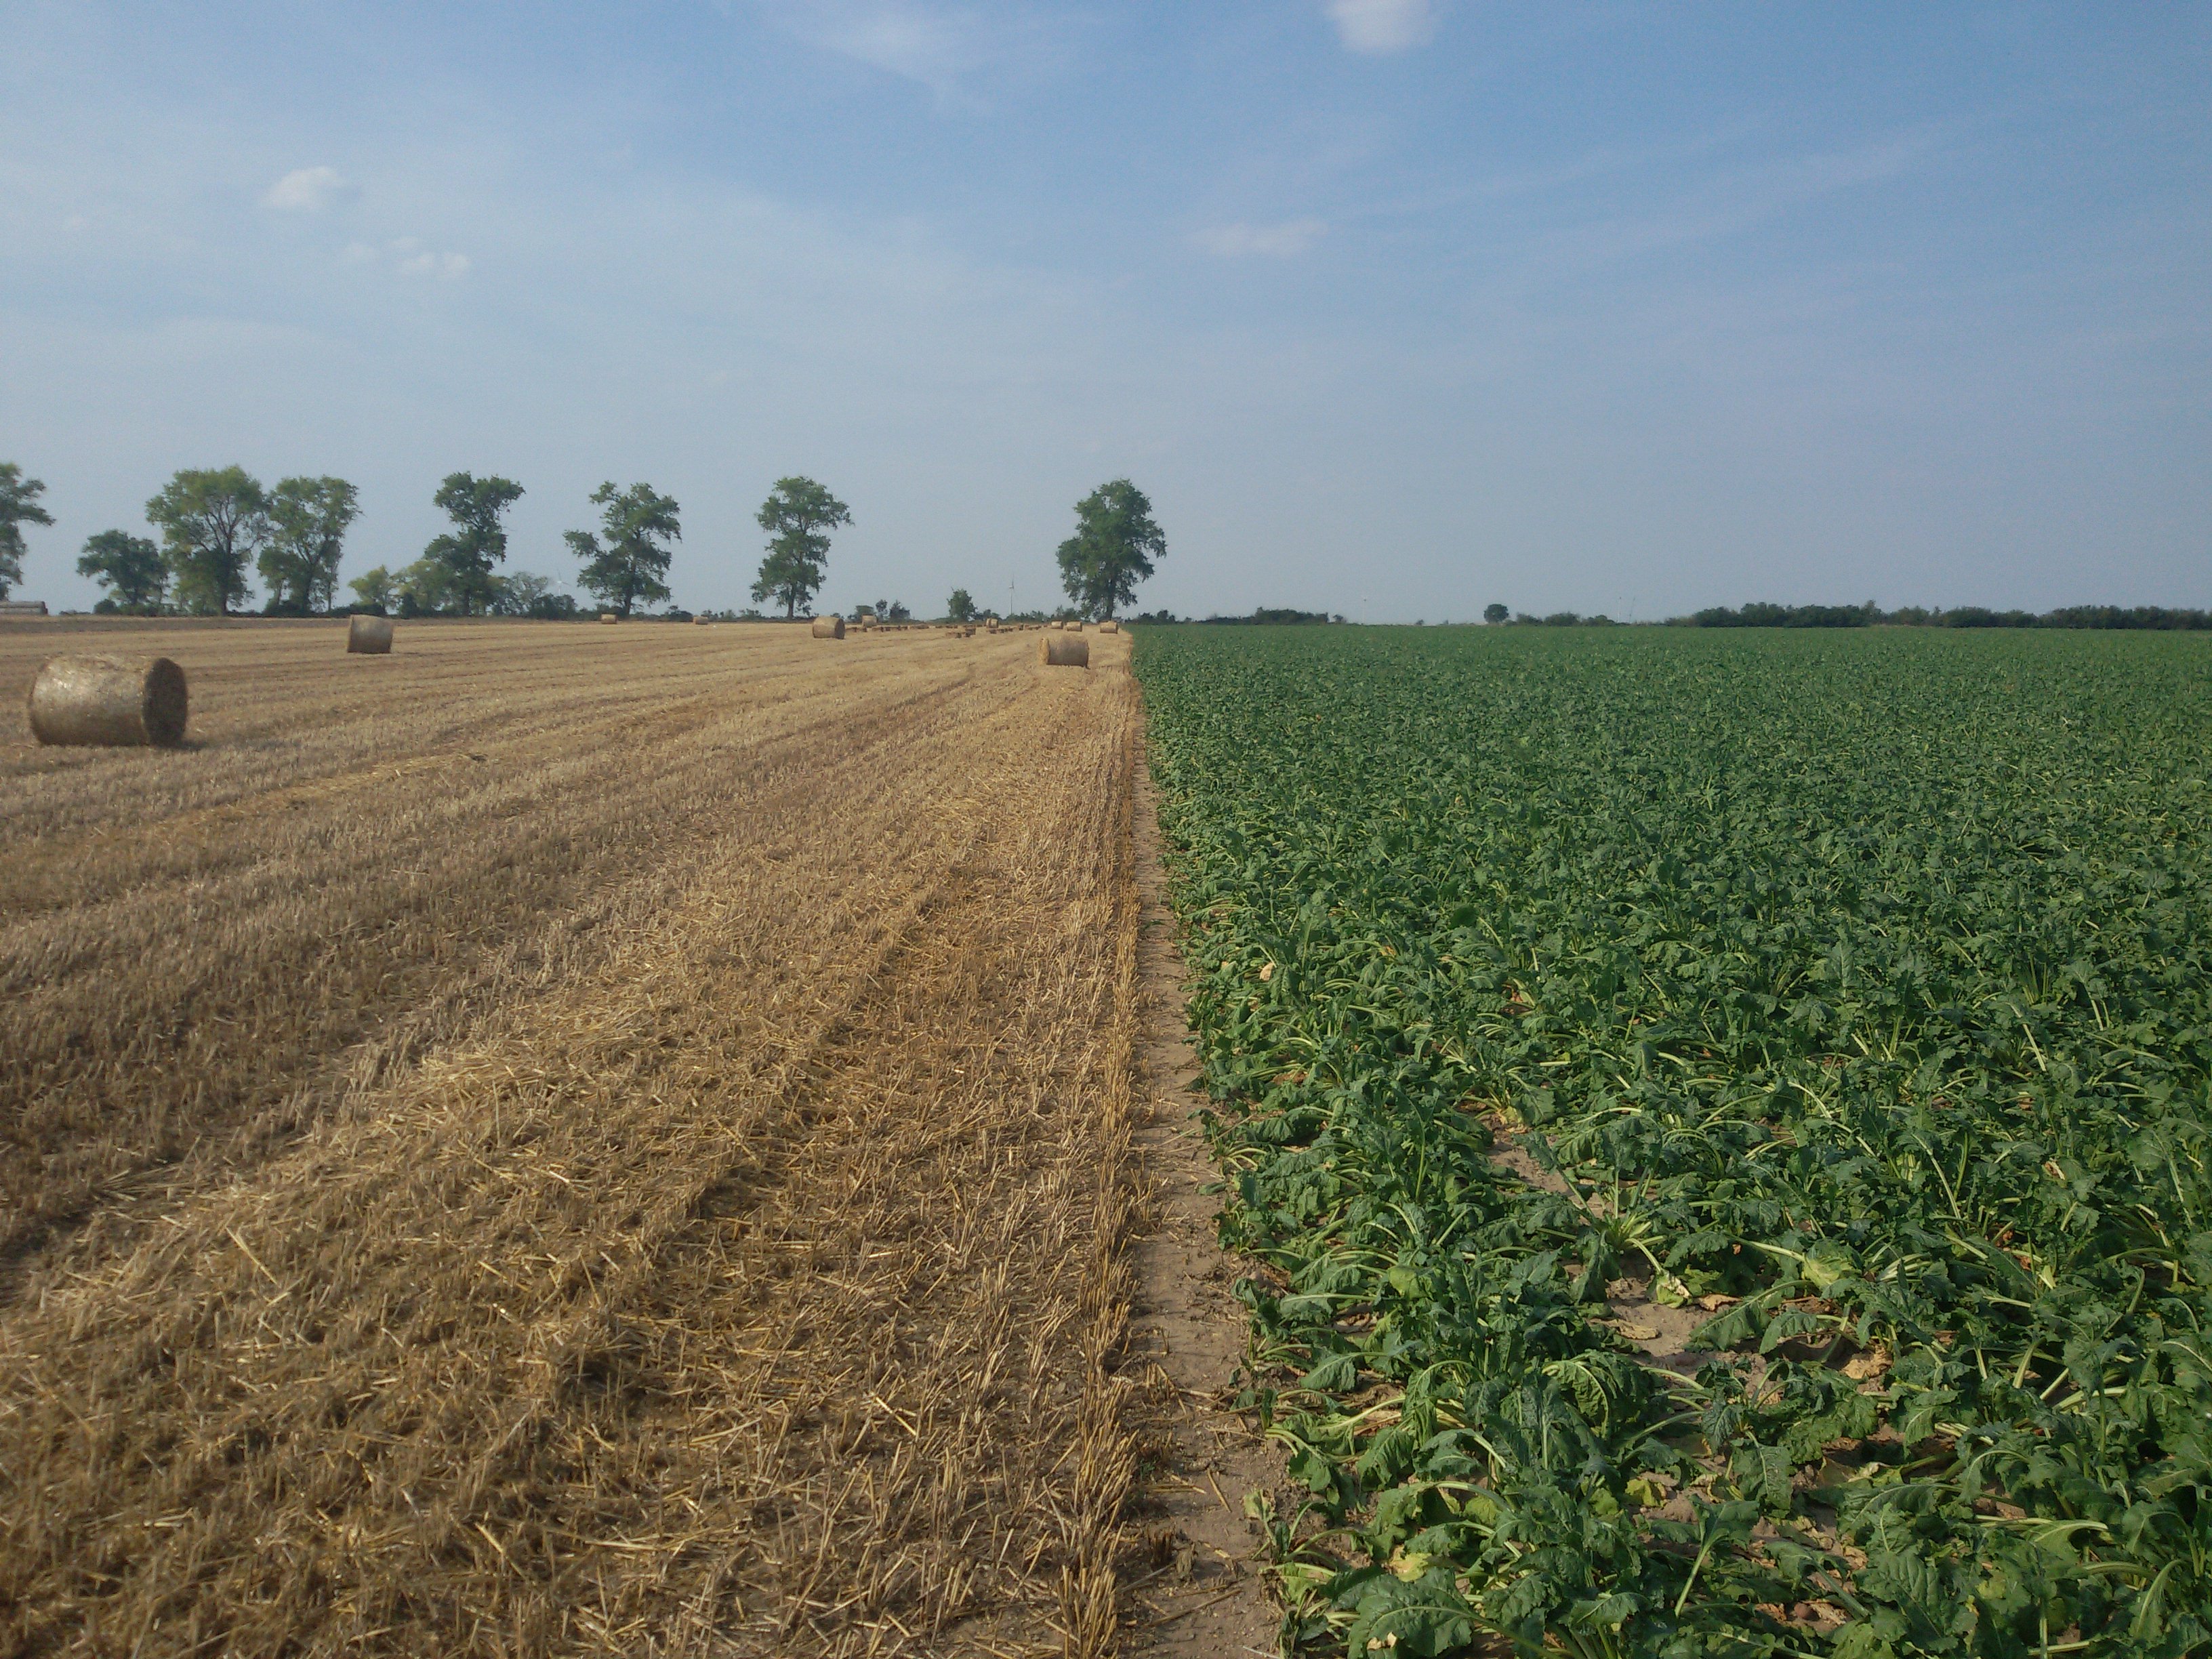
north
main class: Cropland
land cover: Sugar beet
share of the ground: > 75 %
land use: Agriculture (excluding fallow land and kitchen gardens)
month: August
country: PL
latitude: 51.8020
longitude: 17.4227
